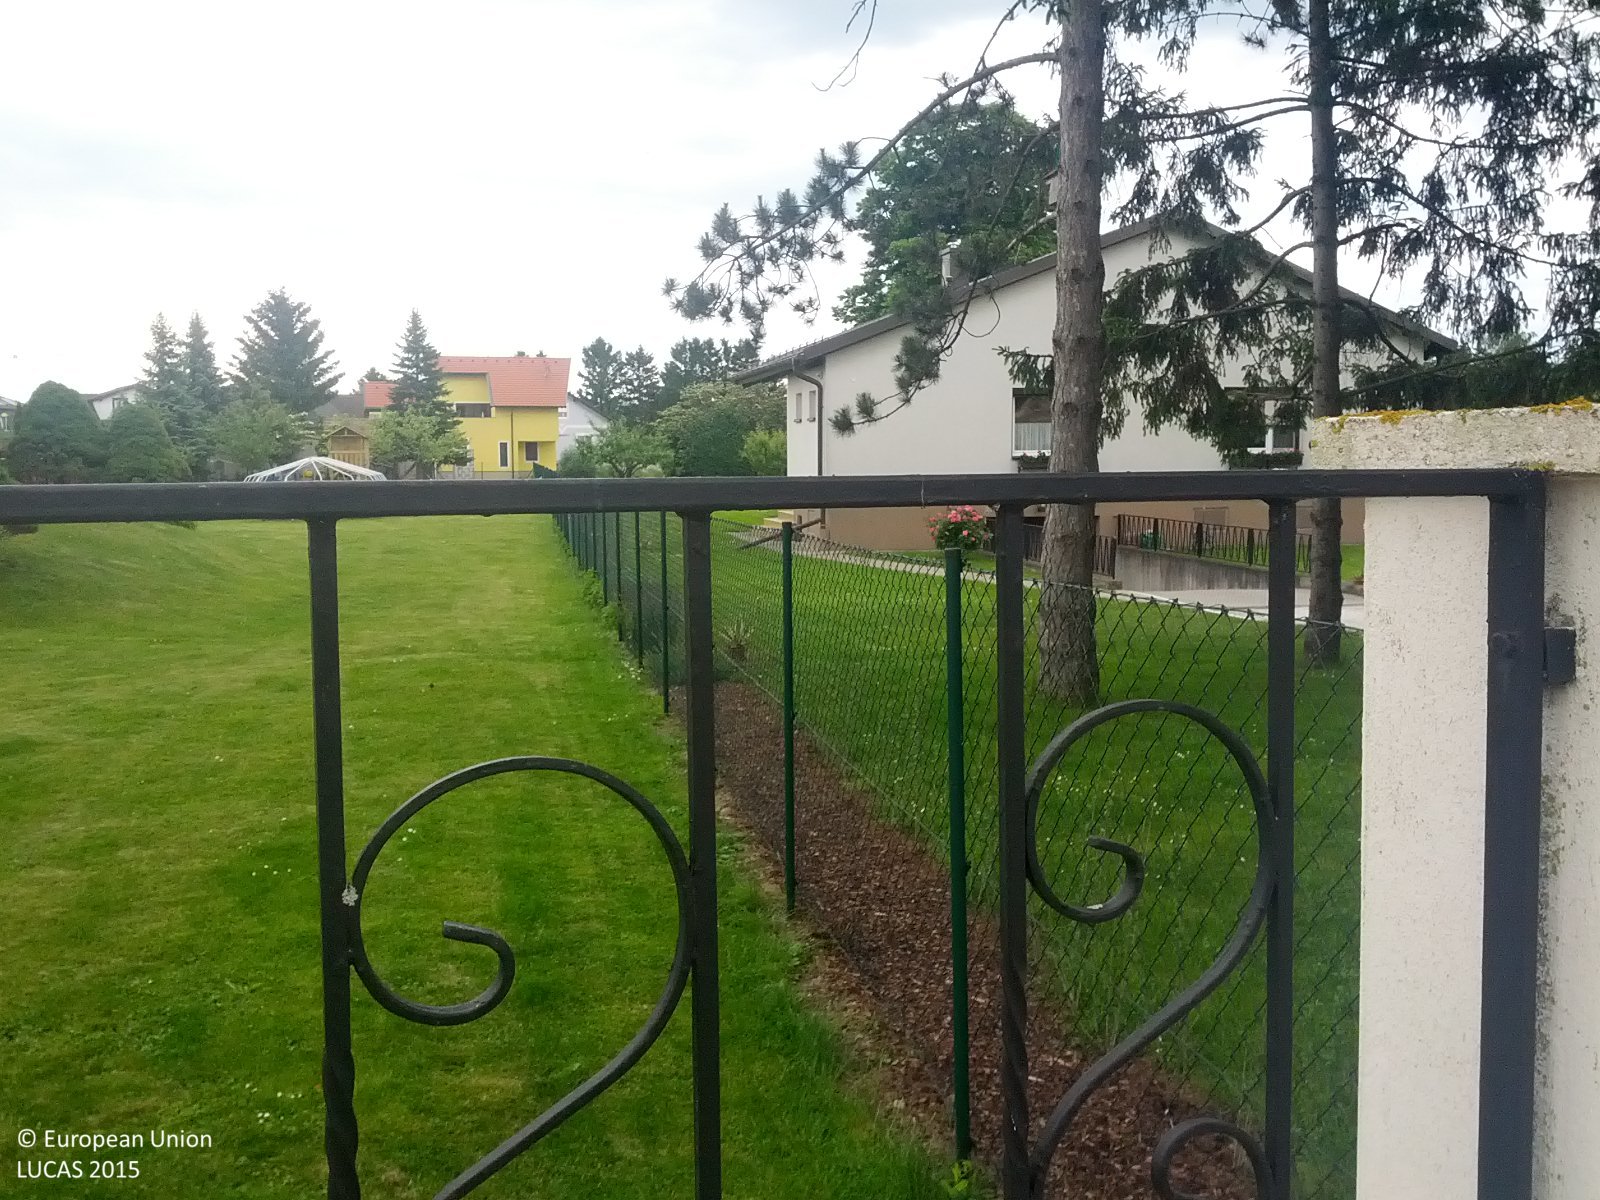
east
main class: Grassland
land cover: Grassland with sparse tree/shrub cover
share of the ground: > 75 %
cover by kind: herbaceous plants 90 %, coniferous forest trees 5 %, shrubs 5 %
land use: Residential
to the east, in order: Grassland with sparse tree/shrub cover; Artificial constructions in urban areas
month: May
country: AT
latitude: 48.3230
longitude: 16.1409
